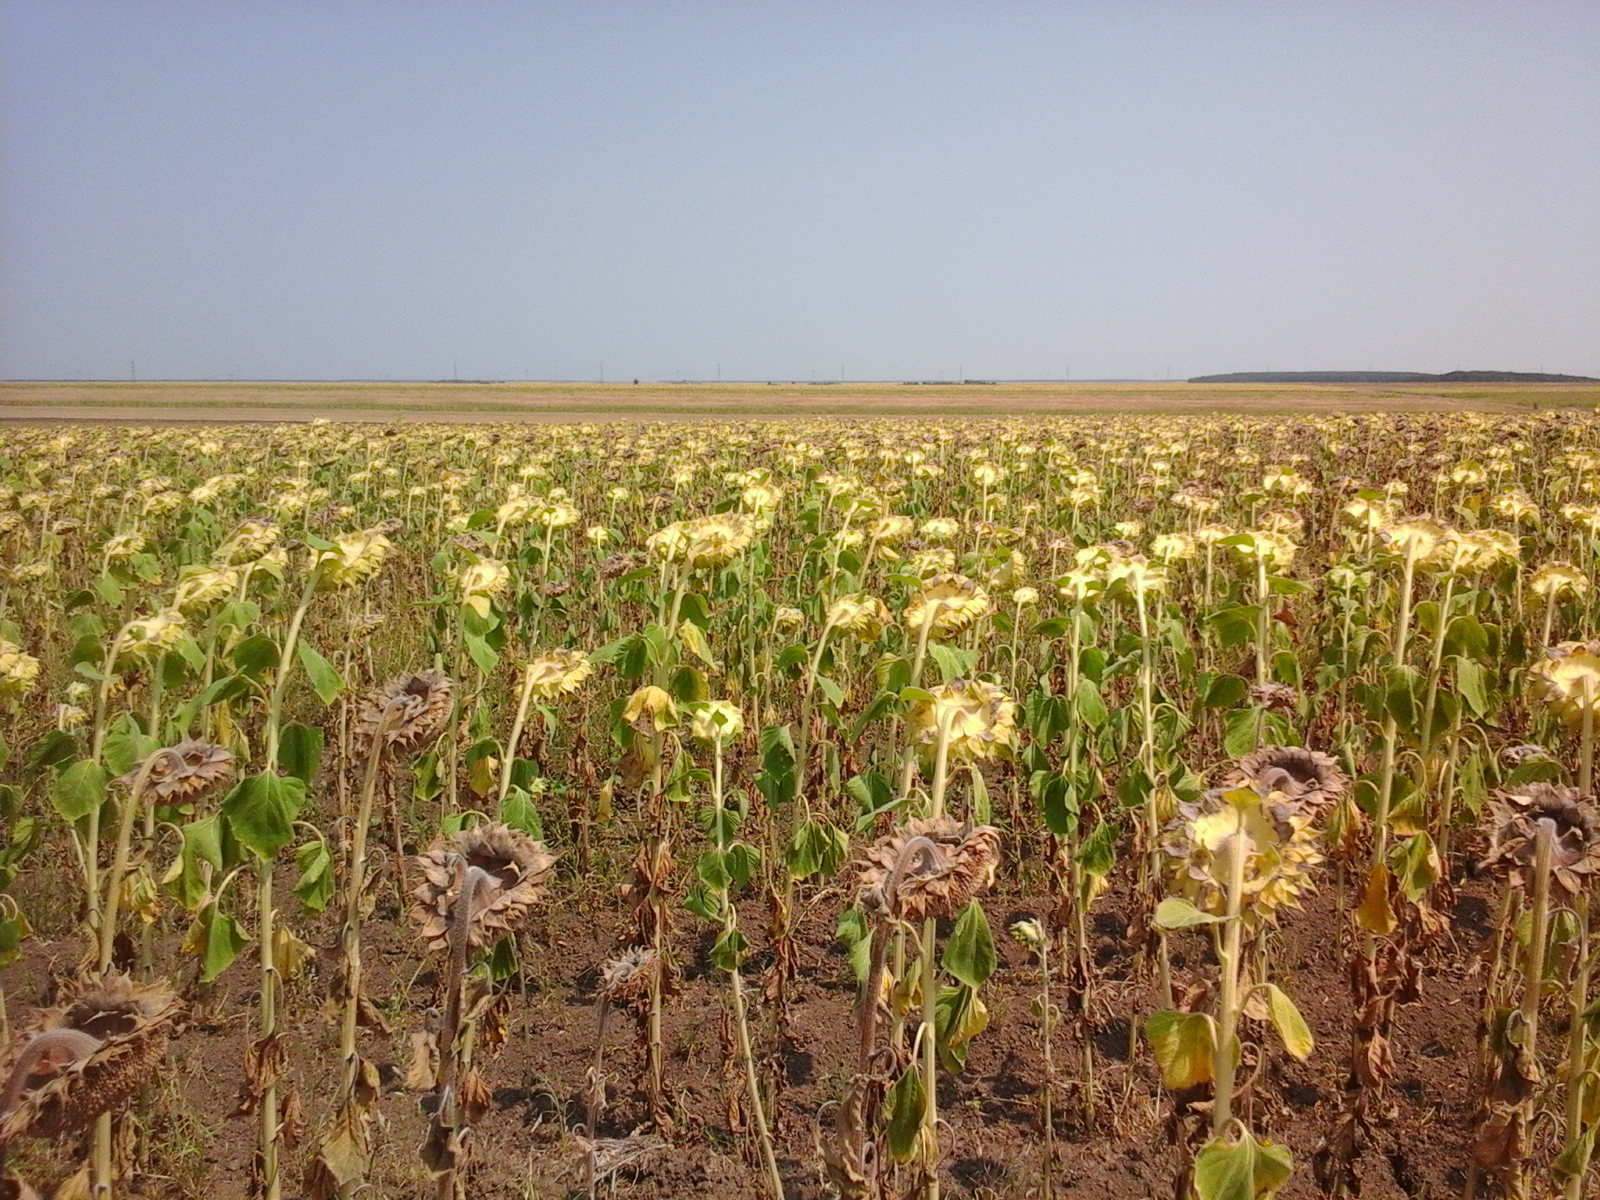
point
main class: Cropland
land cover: Sunflower
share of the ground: > 75 %
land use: Agriculture (excluding fallow land and kitchen gardens)
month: August
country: RO
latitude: 44.4866
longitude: 23.7762
